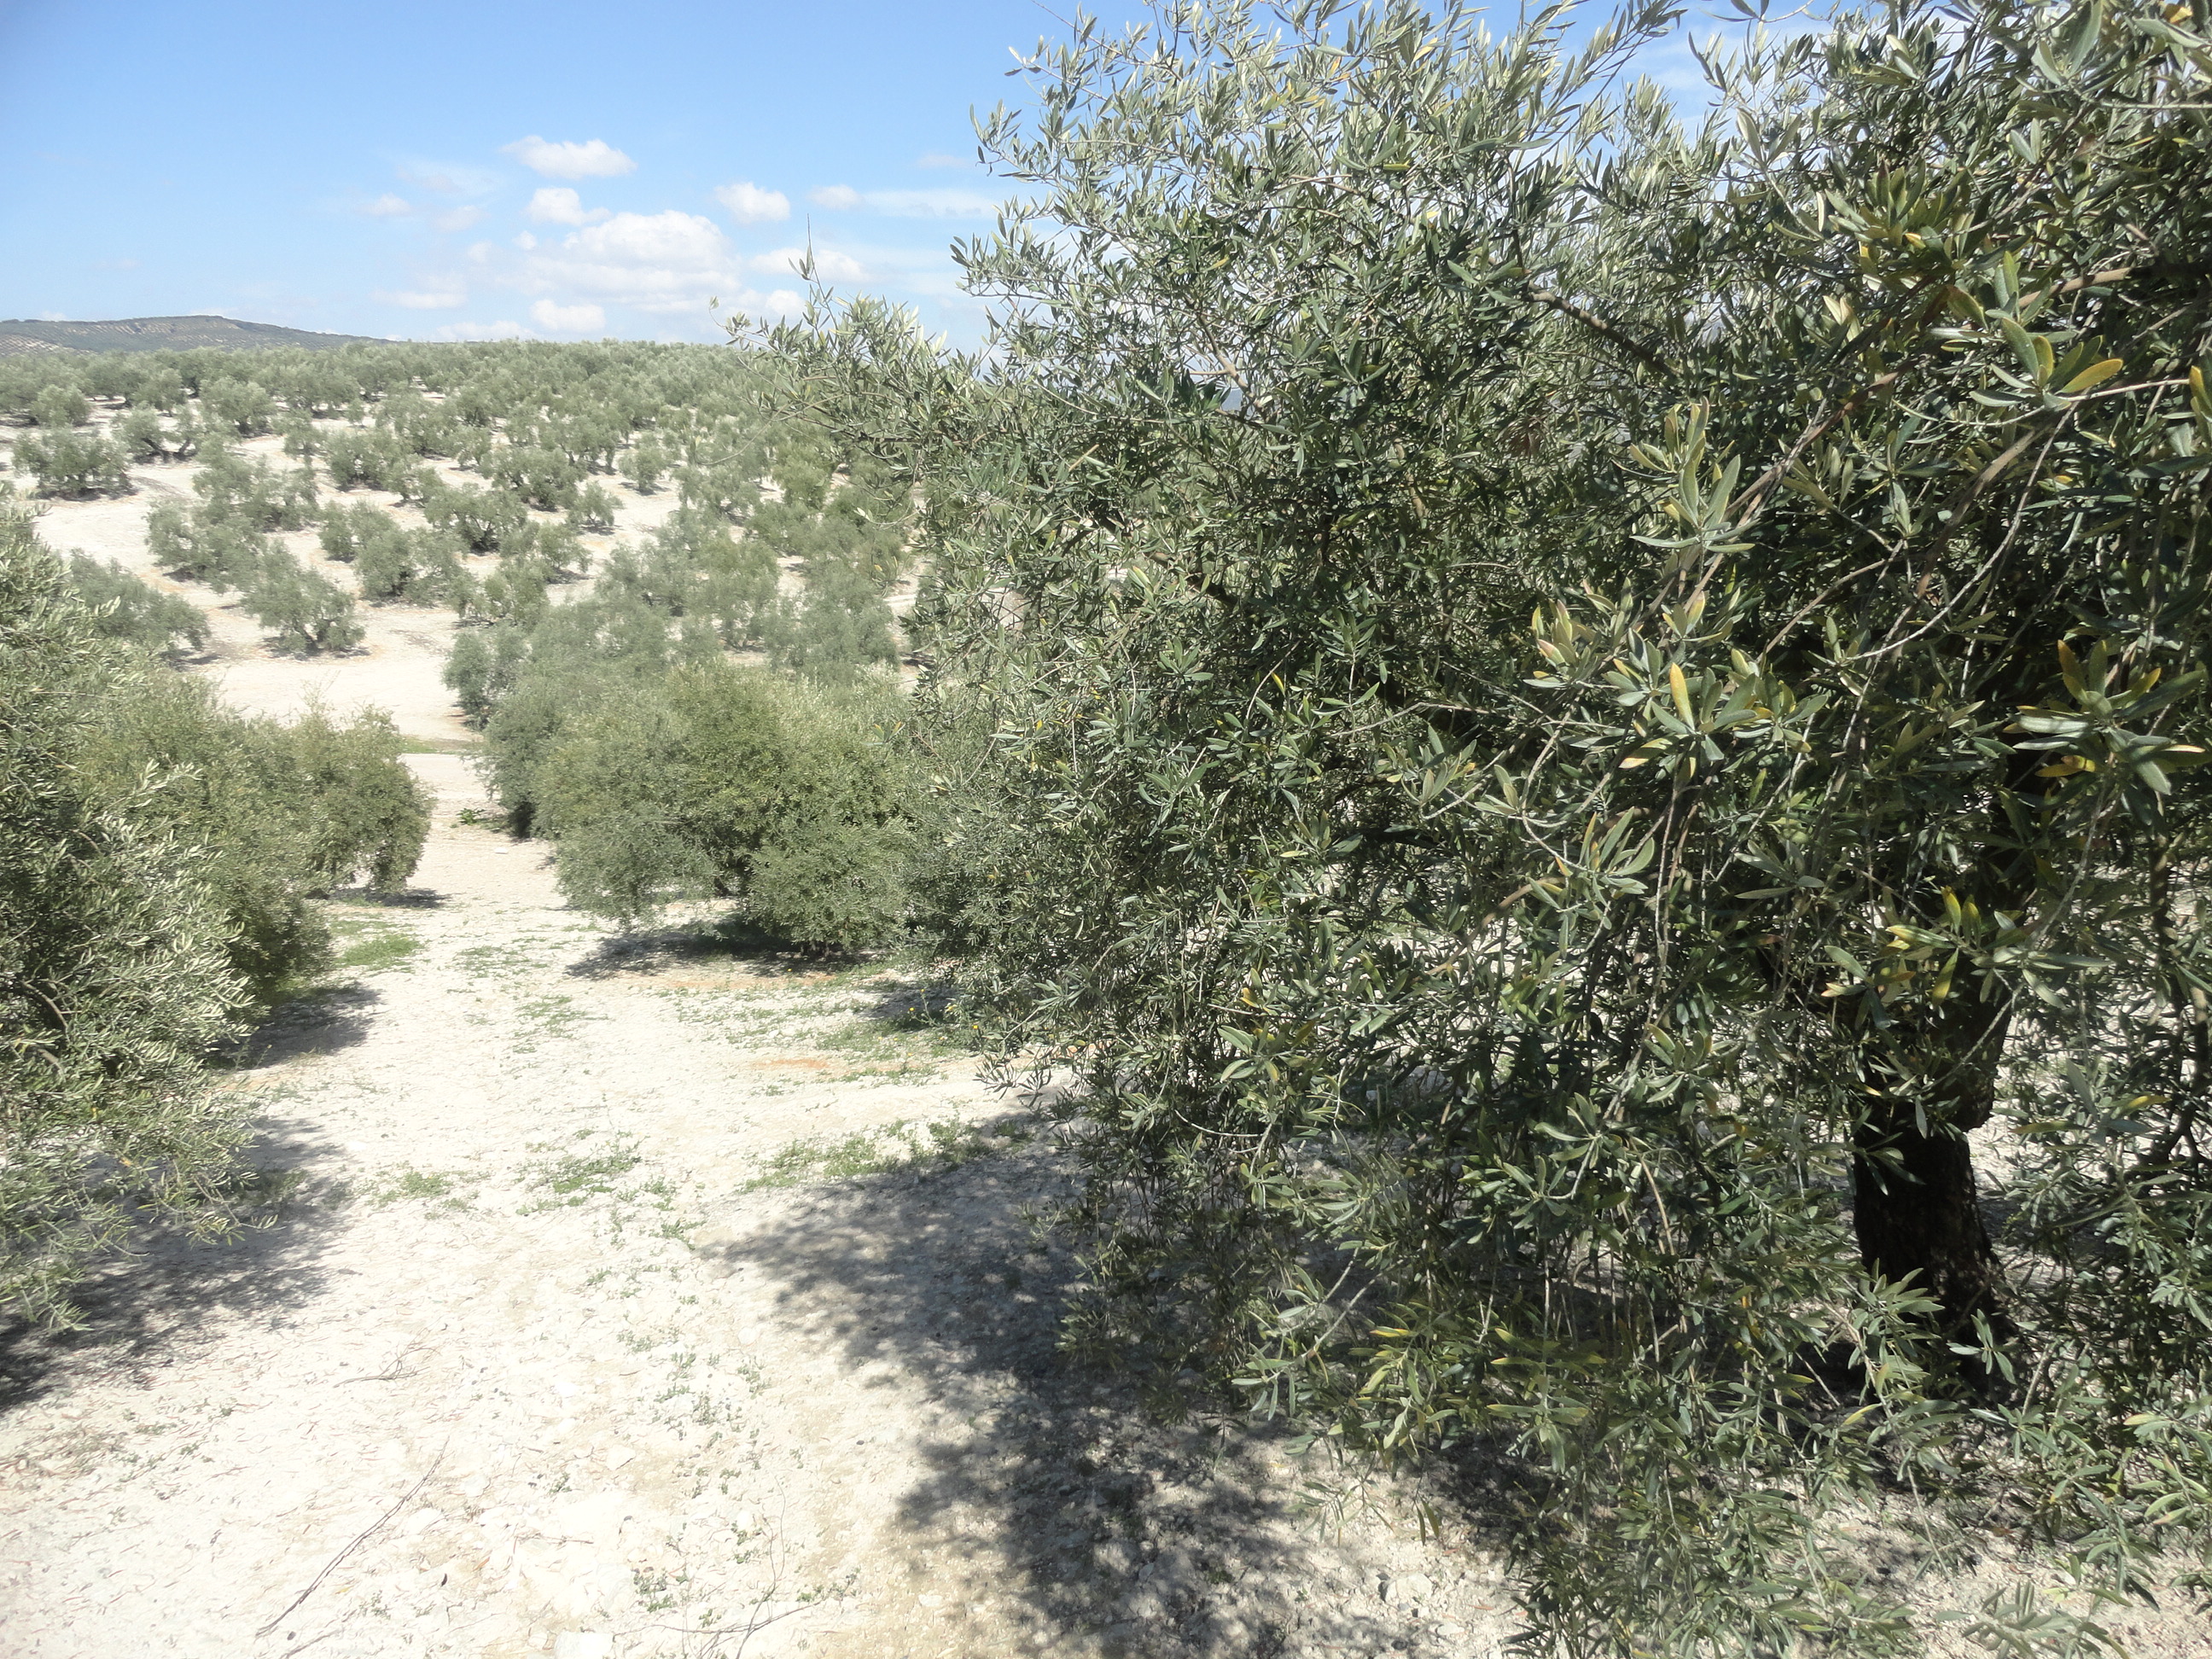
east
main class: Cropland
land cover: Olive groves
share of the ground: 50 - 75 %
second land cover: Other bare soil
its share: > 75 %
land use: Agriculture (excluding fallow land and kitchen gardens)
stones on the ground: 10 - 25 %
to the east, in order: Olive groves; Other bare soil; Grass margins; Tracks; Grass margins; Olive groves; Other structural elements; Grass margins; Olive groves; Grass margins; Olive groves
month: April
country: ES
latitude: 37.5341
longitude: -4.4787
